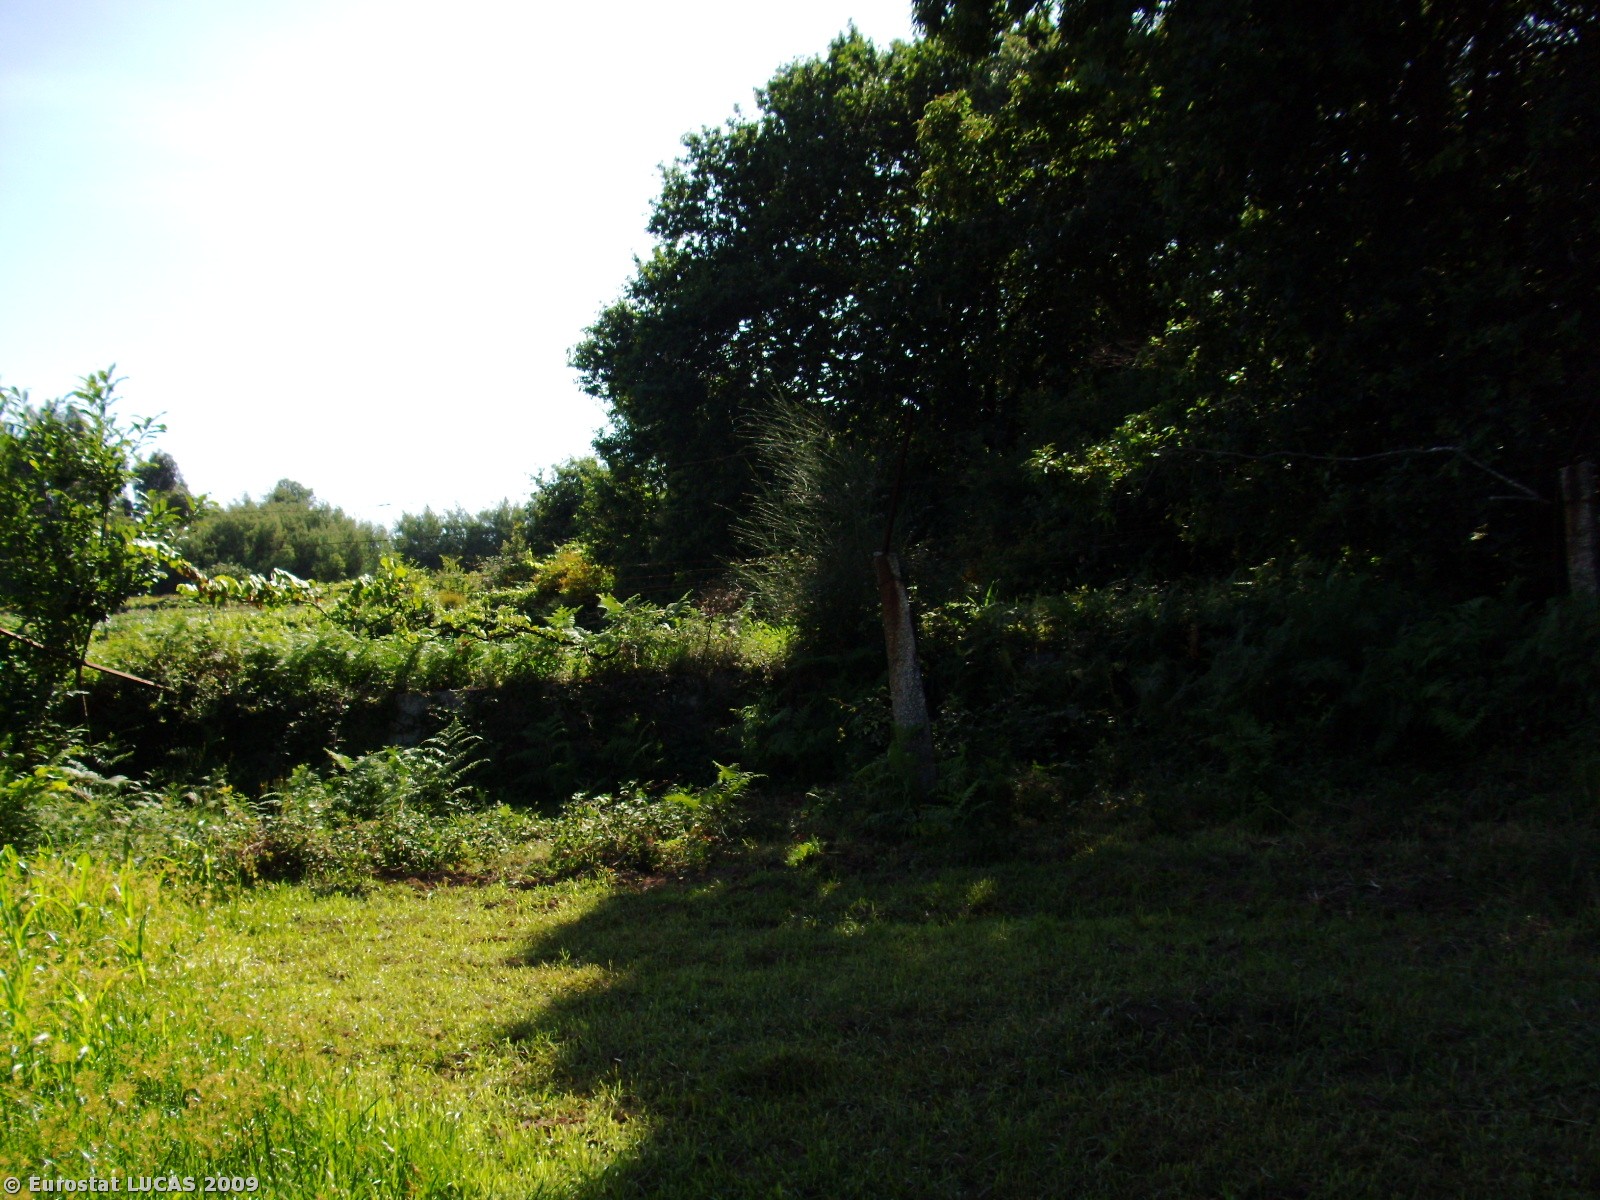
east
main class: Woodland
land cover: Broadleaved woodland
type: acidophilous oak and oak-birch forest
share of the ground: 50 - 75 %
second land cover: Spontaneously vegetated surfaces
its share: 25 - 50 %
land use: Agriculture (excluding fallow land and kitchen gardens)
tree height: > 5 m
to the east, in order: Broadleaved woodland; Spontaneously vegetated surfaces; Broadleaved woodland; Spontaneously vegetated surfaces; Dry stone walls; Paved roads, cycling and walking lanes; Maize; Vineyards; Spontaneously vegetated surfaces; Dry stone walls; Paved roads, cycling and walking lanes; Electric lines; Maize; Vineyards; Maize; Vineyards; Maize
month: July
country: PT
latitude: 41.5530
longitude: -8.7346
